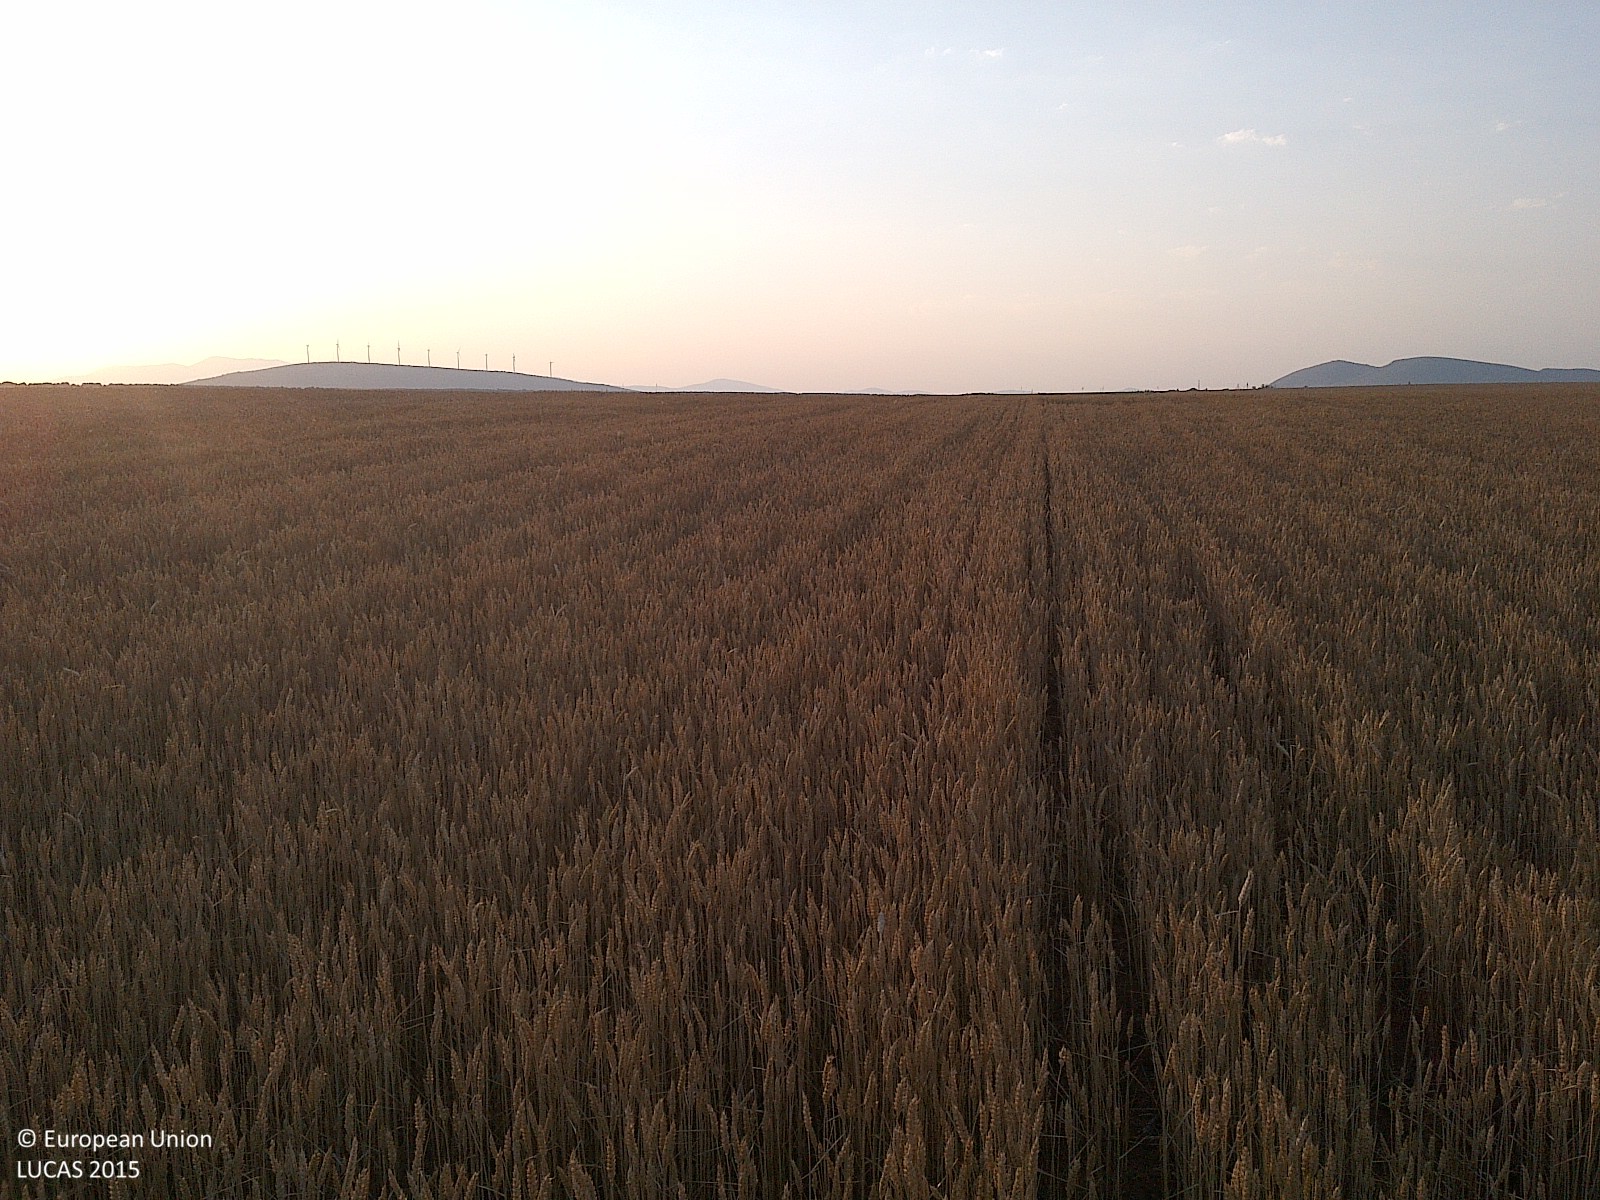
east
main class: Cropland
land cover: Common wheat
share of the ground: > 75 %
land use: Agriculture (excluding fallow land and kitchen gardens)
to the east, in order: Common wheat; Sunflower; Barley
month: June
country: ES
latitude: 41.6910
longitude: -2.2296
